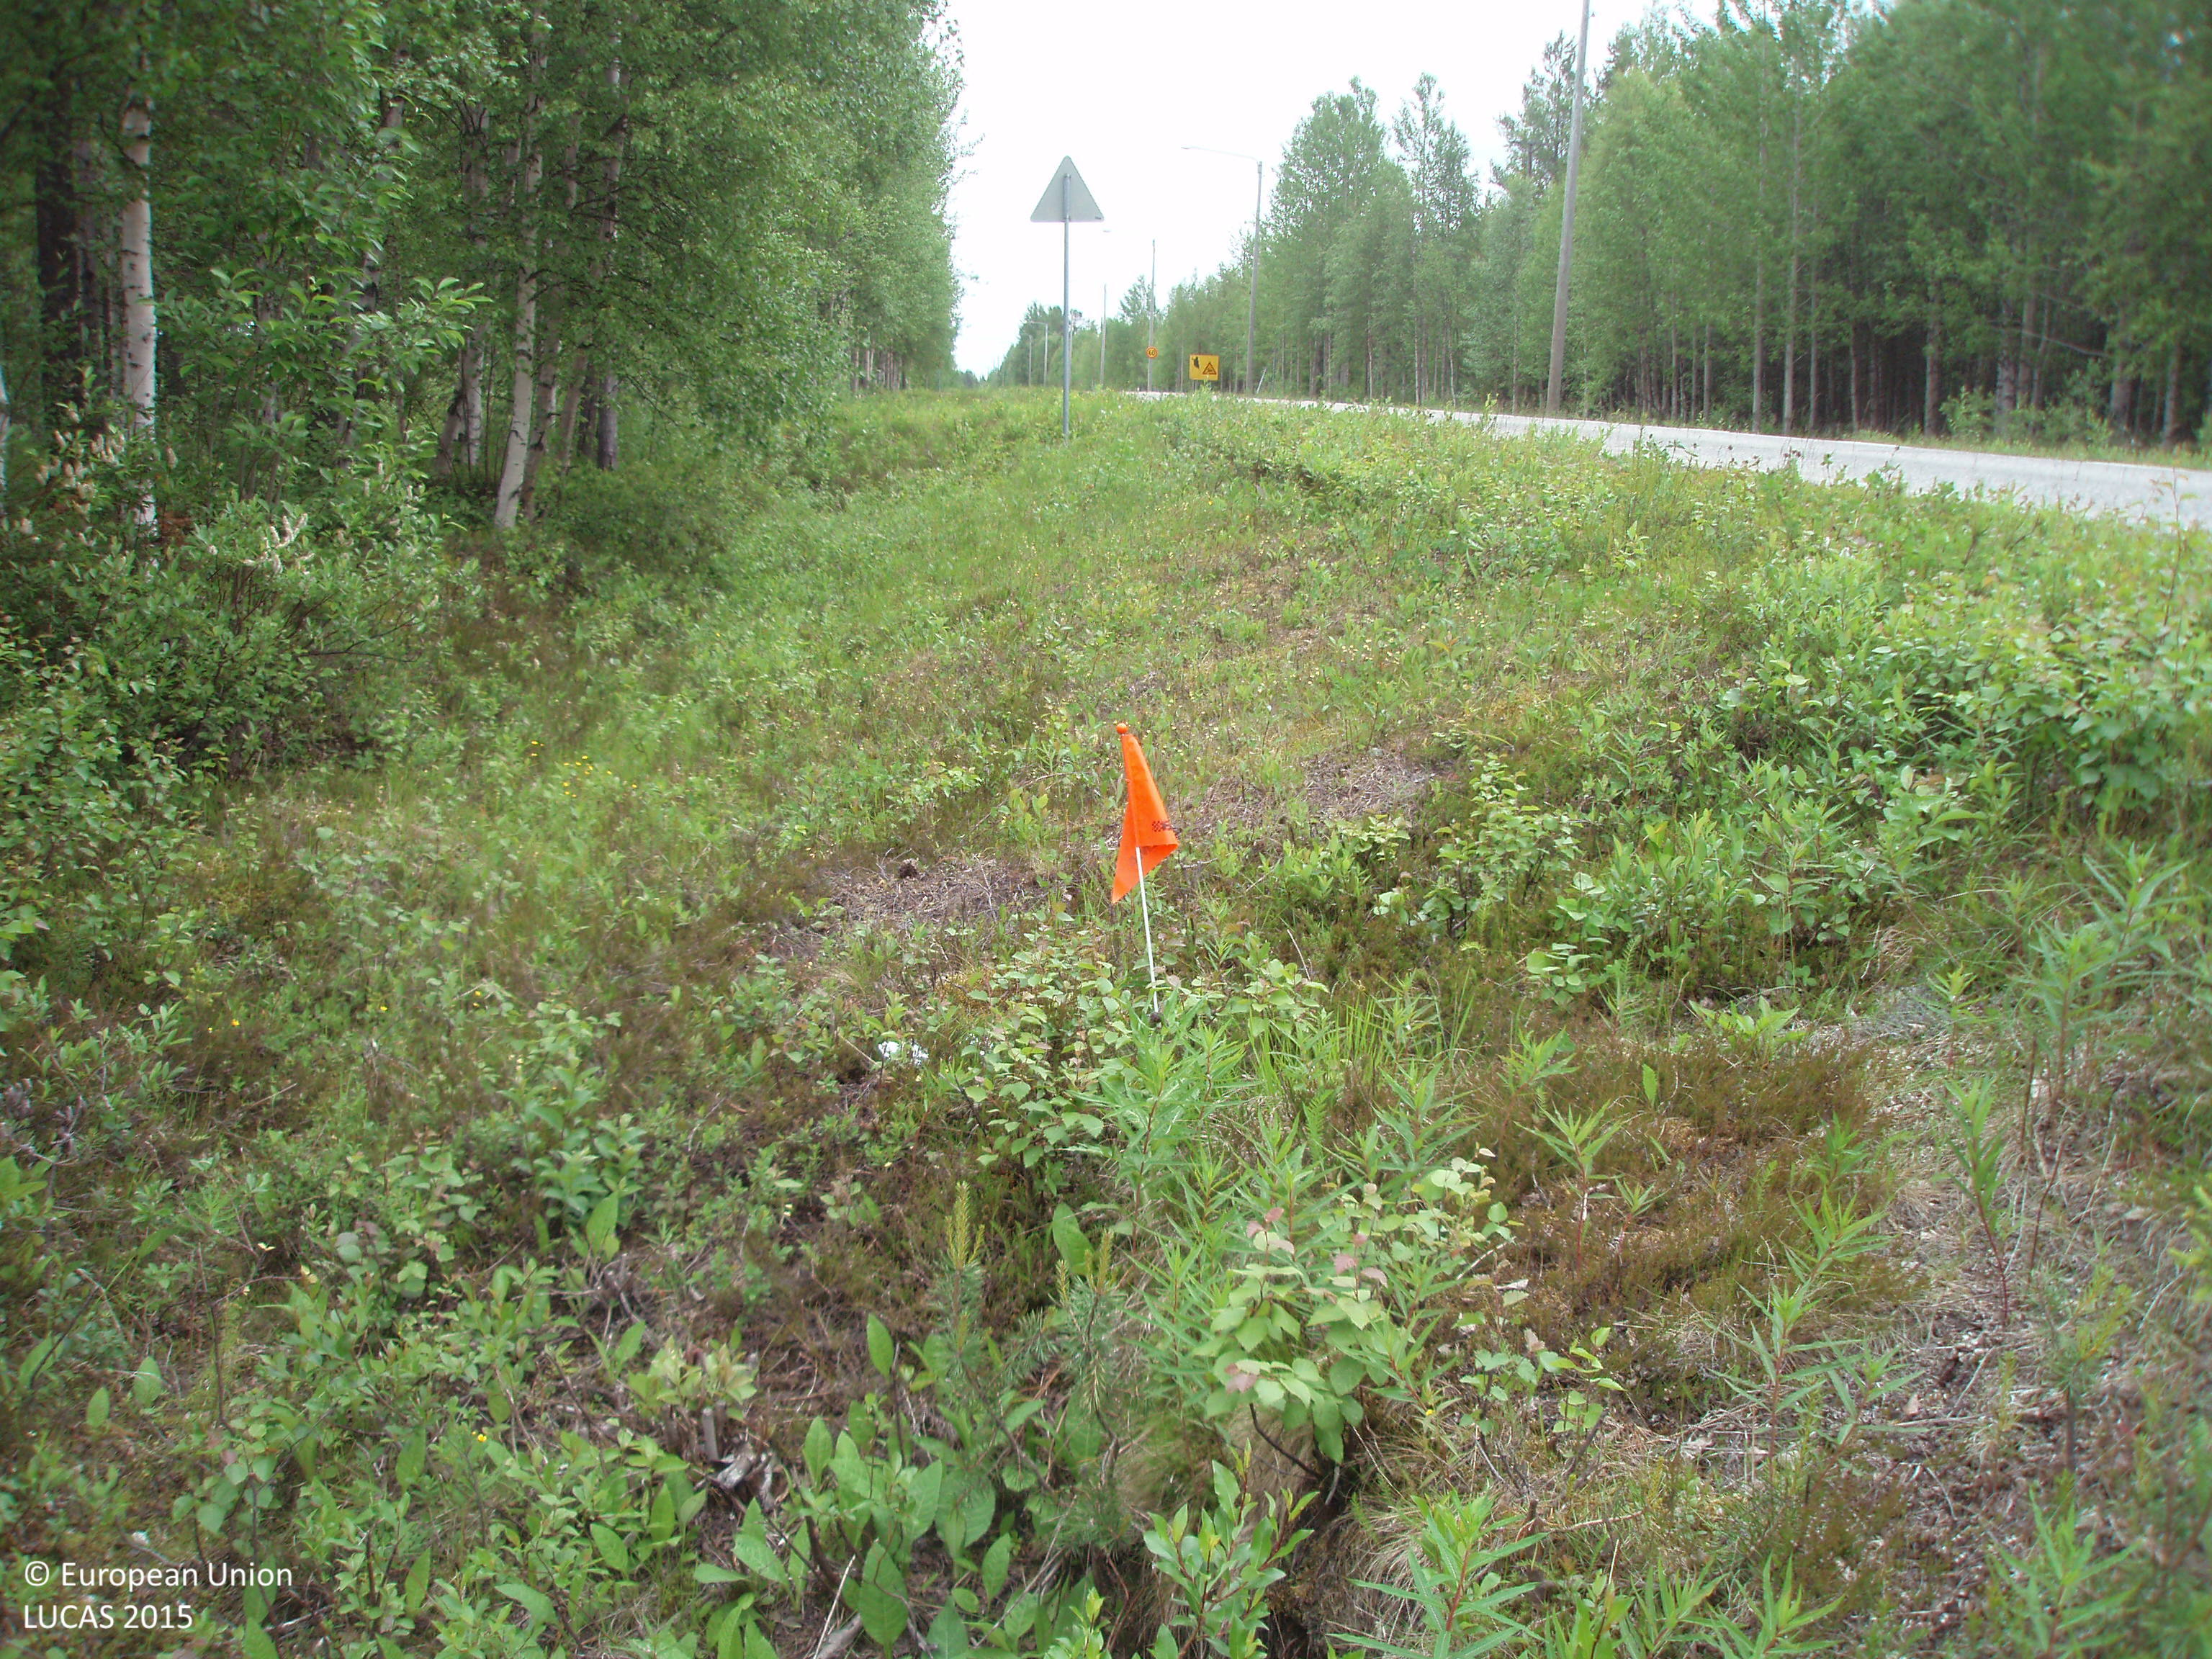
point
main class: Shrubland
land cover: Shrubland with sparse tree cover
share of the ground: > 75 %
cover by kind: shrubs 95 %, broadleaved forest trees 5 %
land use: Road transport
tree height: < 5 m
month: July
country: FI
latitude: 67.2982
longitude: 28.1626
